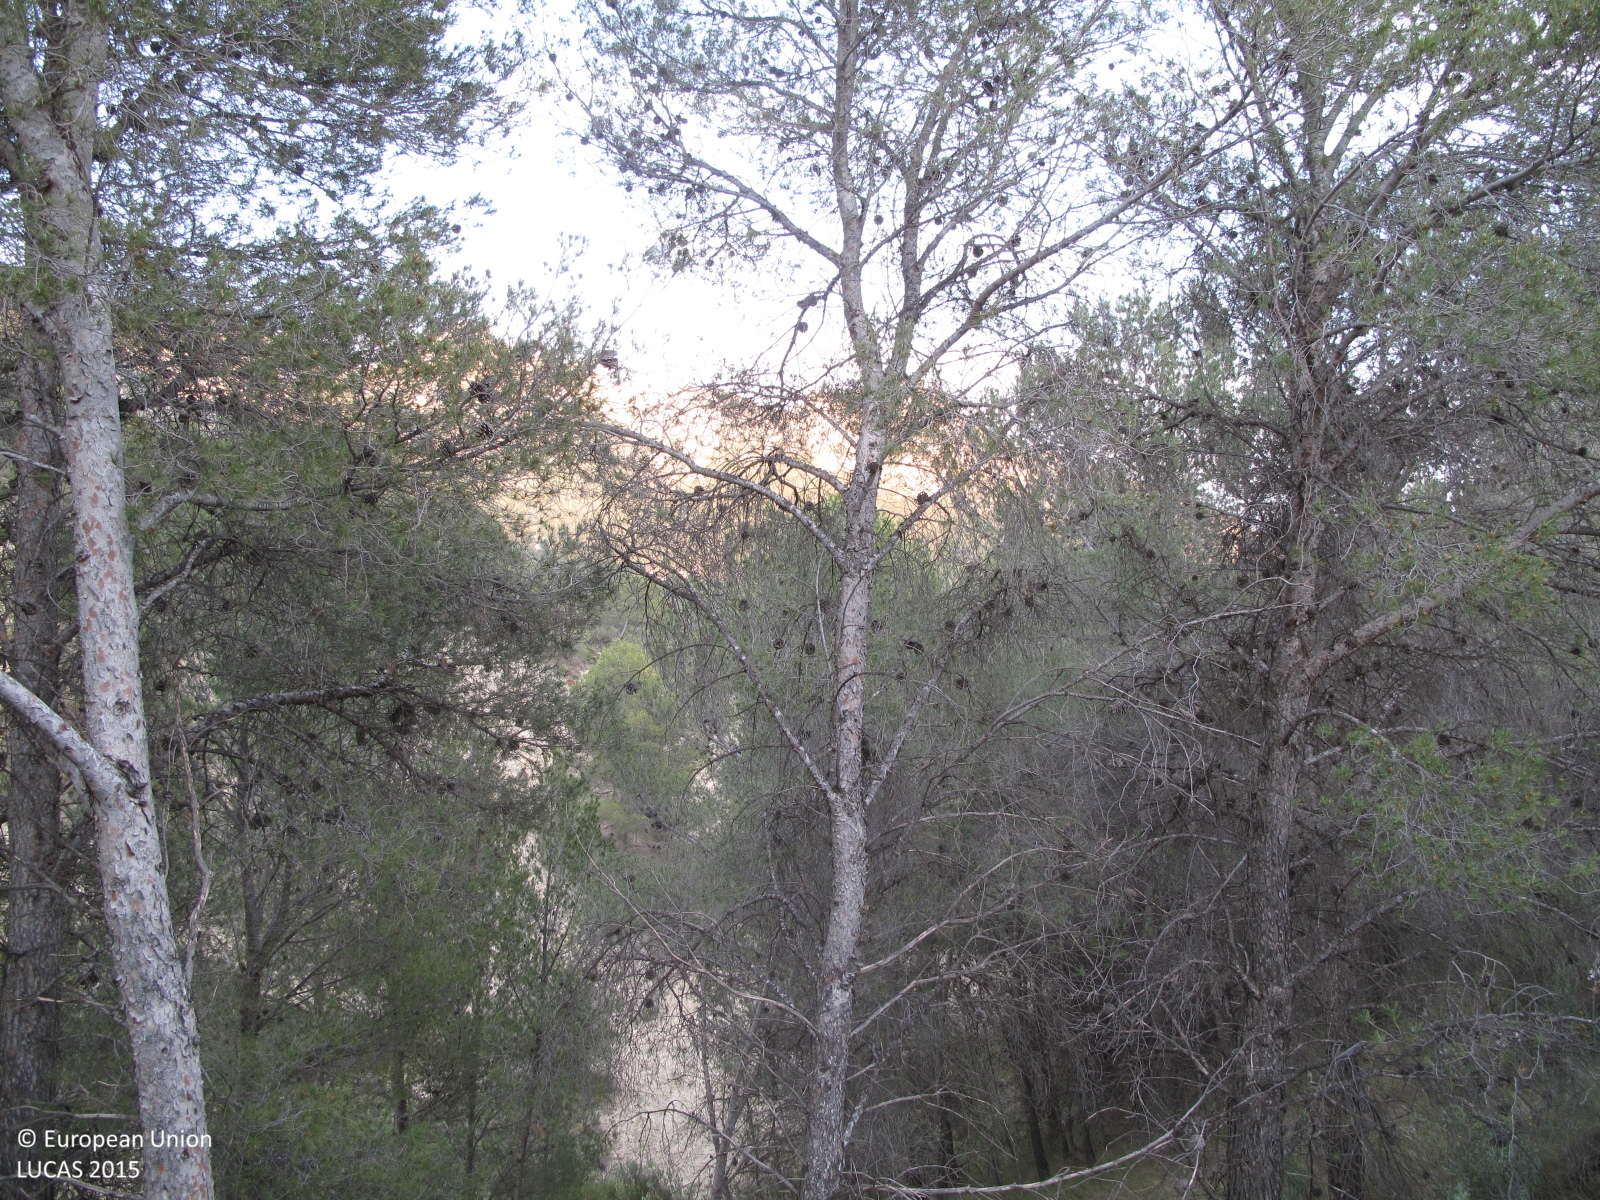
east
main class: Woodland
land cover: Pine dominated coniferous woodland
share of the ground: 25 - 50 %
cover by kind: coniferous forest trees 40 %, shrubs 30 %, herbaceous plants 20 %, consolidated bare surface 10 %
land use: Semi-natural and natural areas not in use
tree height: > 5 m
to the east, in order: Pine dominated coniferous woodland; Other bare soil; Shrubland with sparse tree cover; Pine dominated coniferous woodland
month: April
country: ES
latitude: 38.4984
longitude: -0.6628
